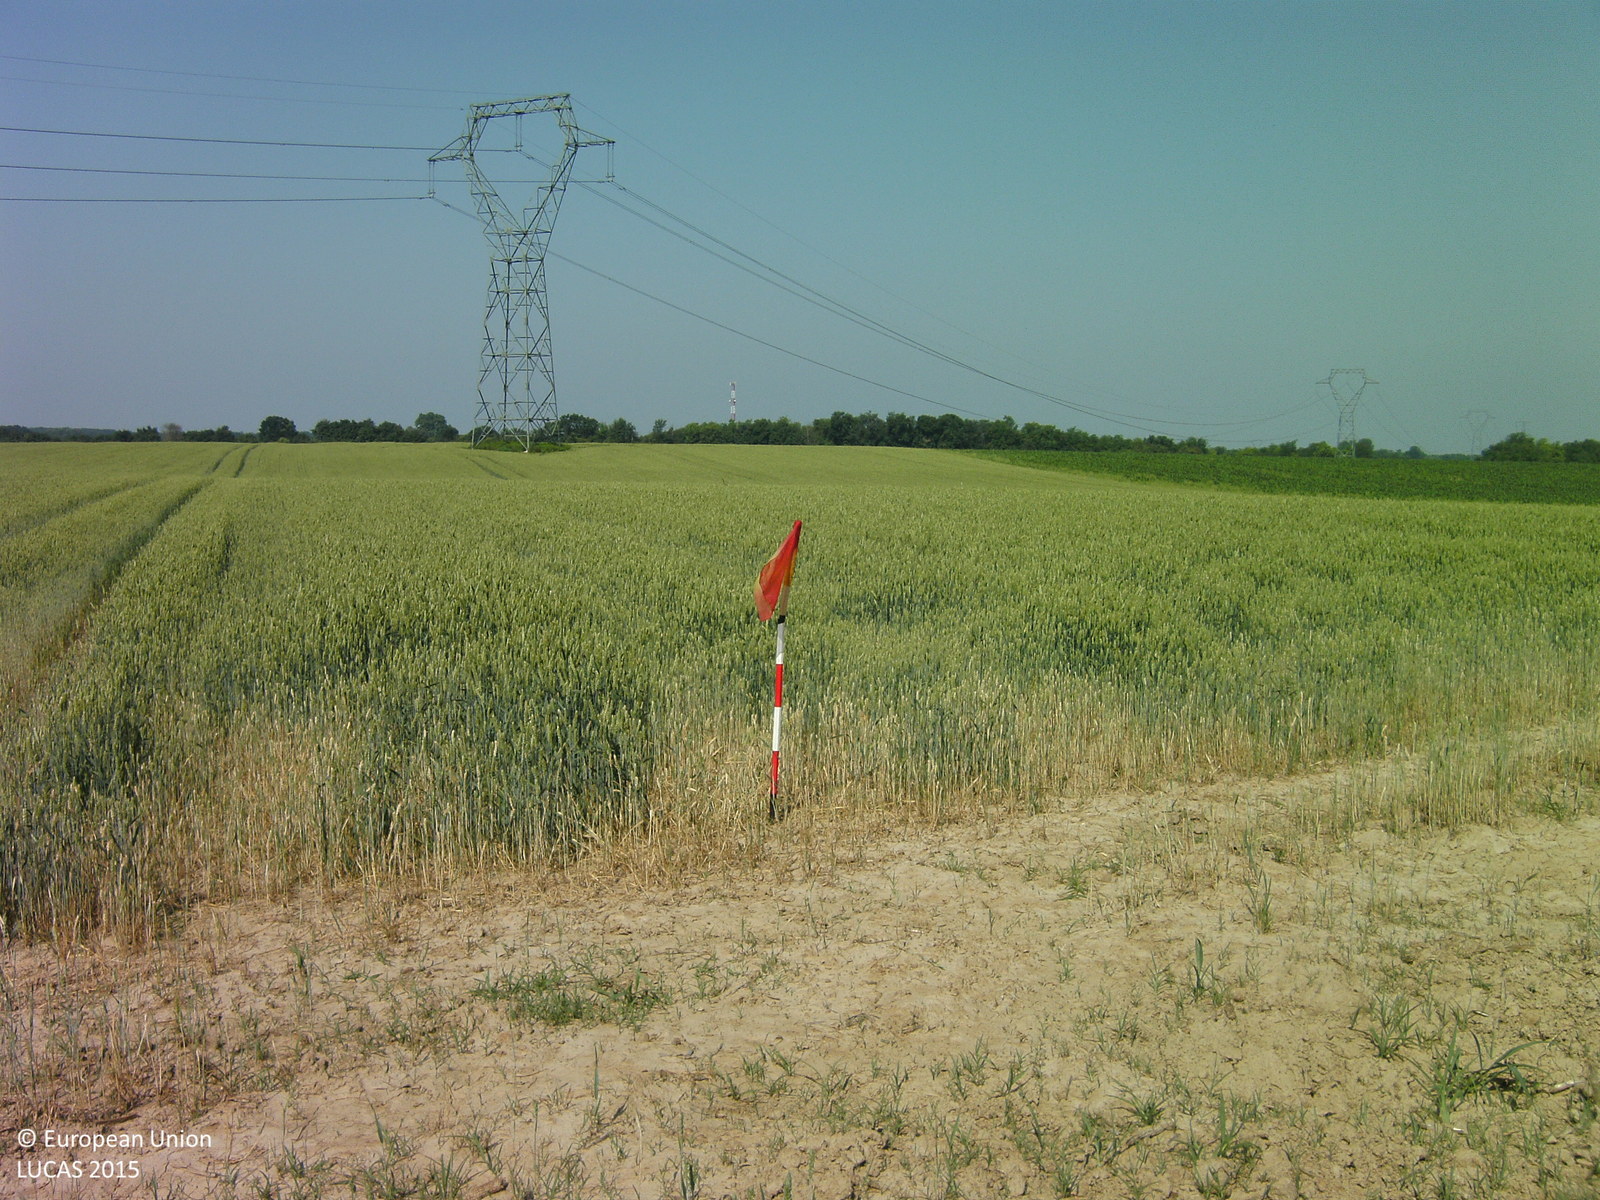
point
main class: Cropland
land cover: Common wheat
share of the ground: > 75 %
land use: Agriculture (excluding fallow land and kitchen gardens)
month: June
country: HU
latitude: 46.4730
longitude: 17.6767
